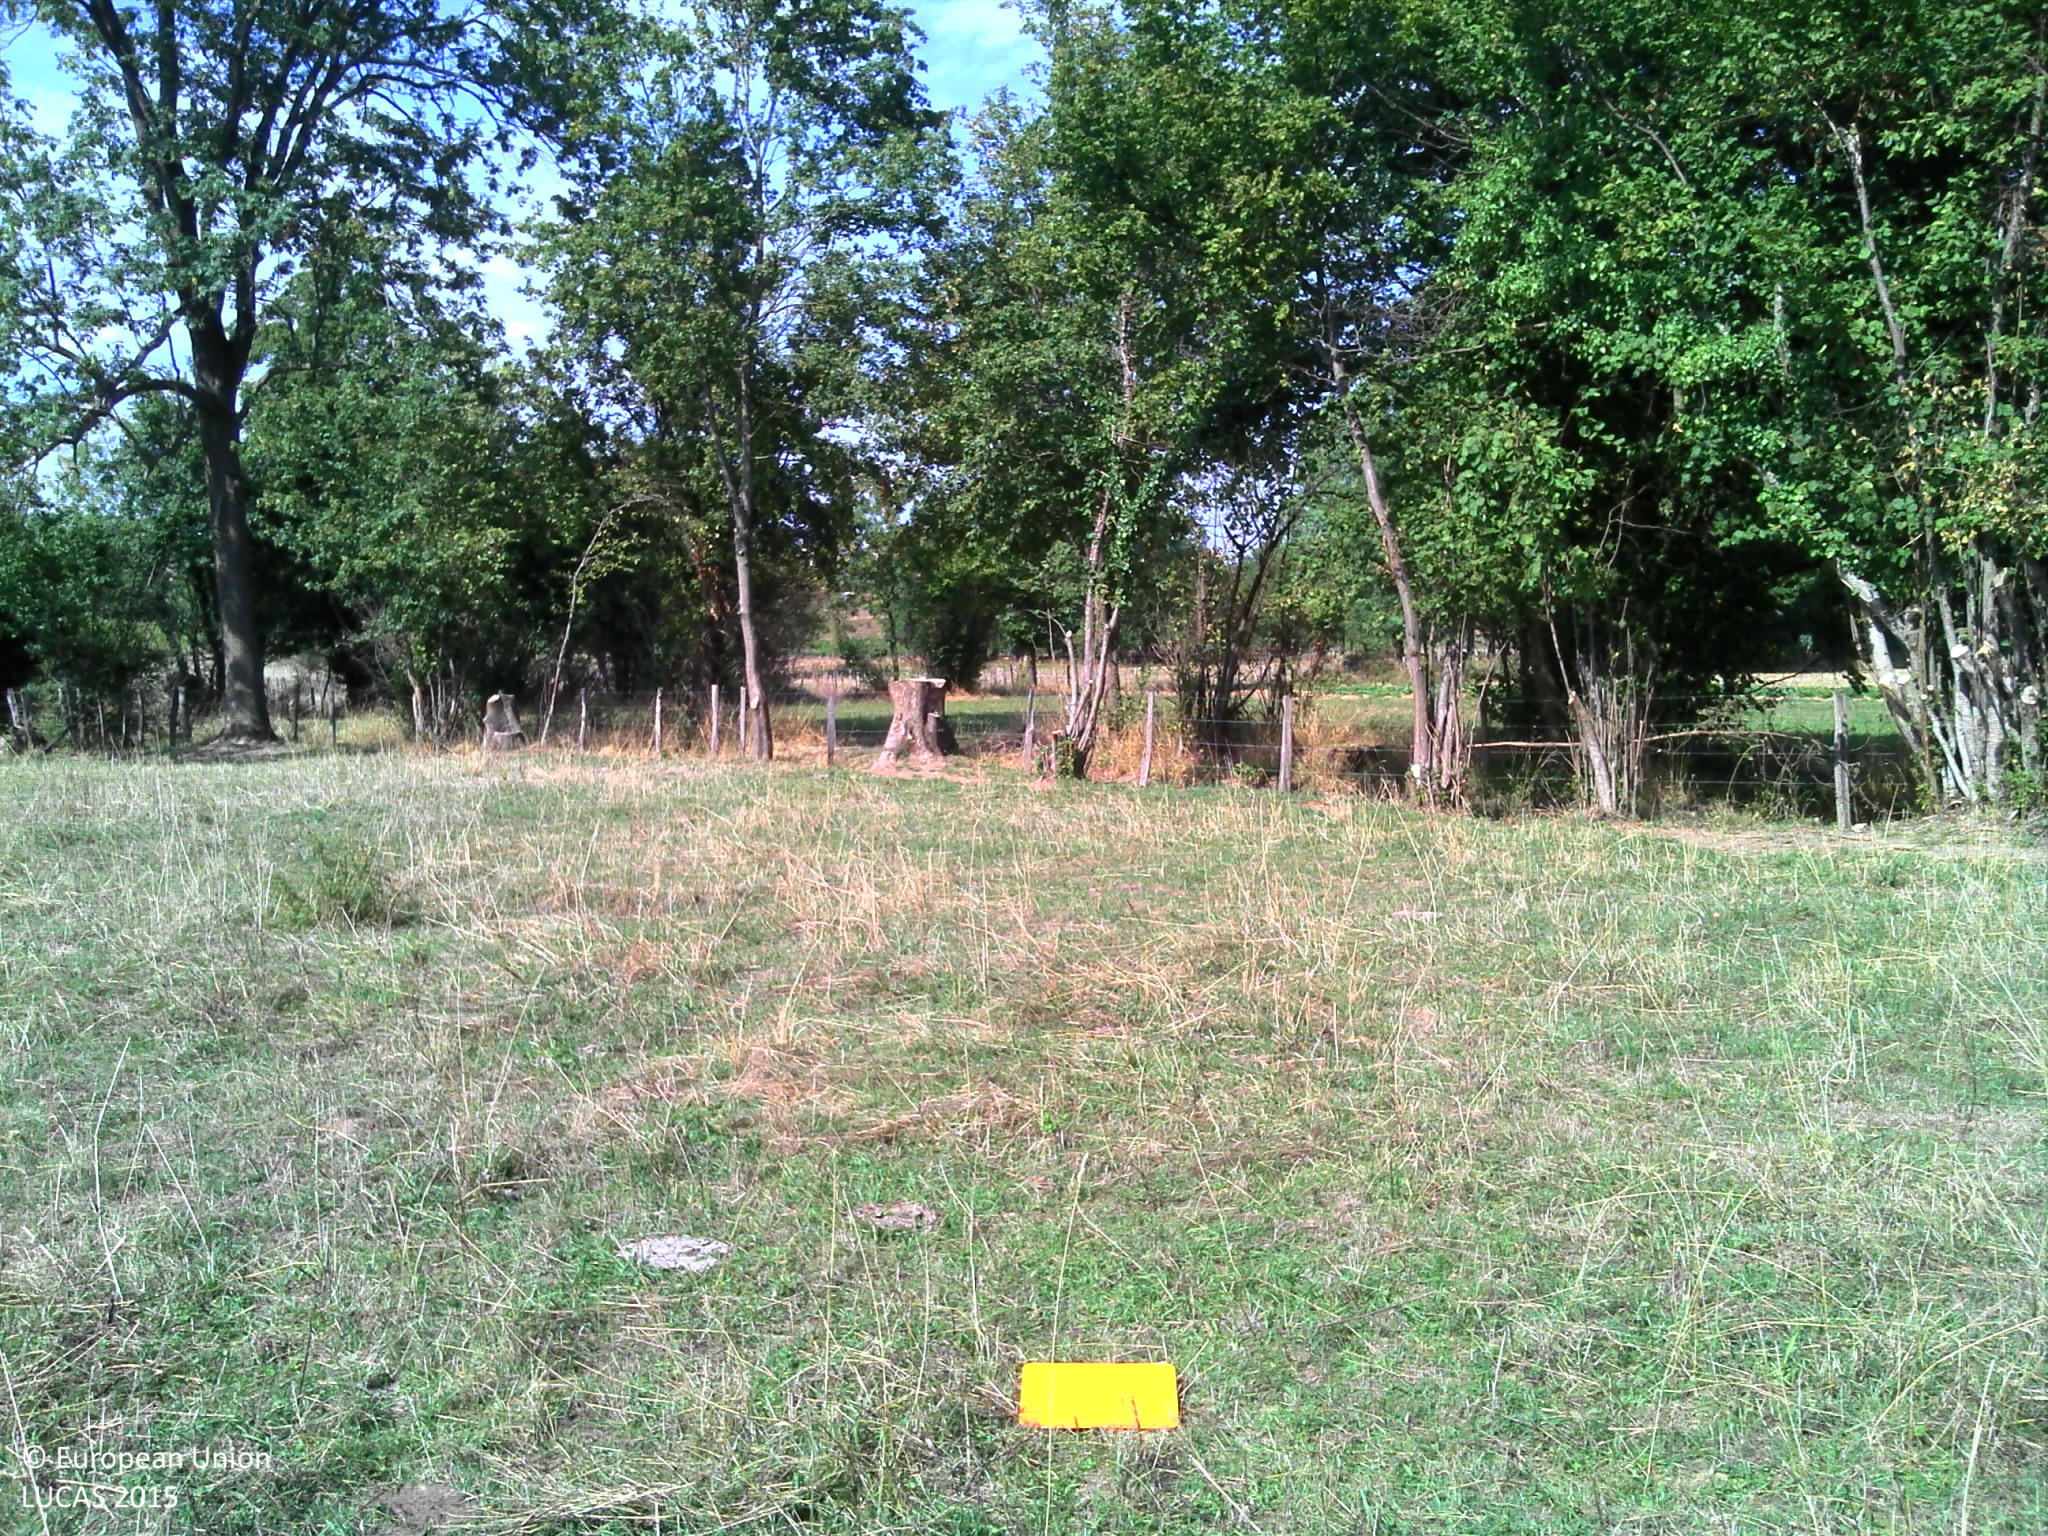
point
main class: Grassland
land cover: Grassland without tree/shrub cover
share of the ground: > 75 %
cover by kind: herbaceous plants 100 %
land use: Agriculture (excluding fallow land and kitchen gardens)
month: August
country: FR
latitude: 46.0556
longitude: 4.6644
